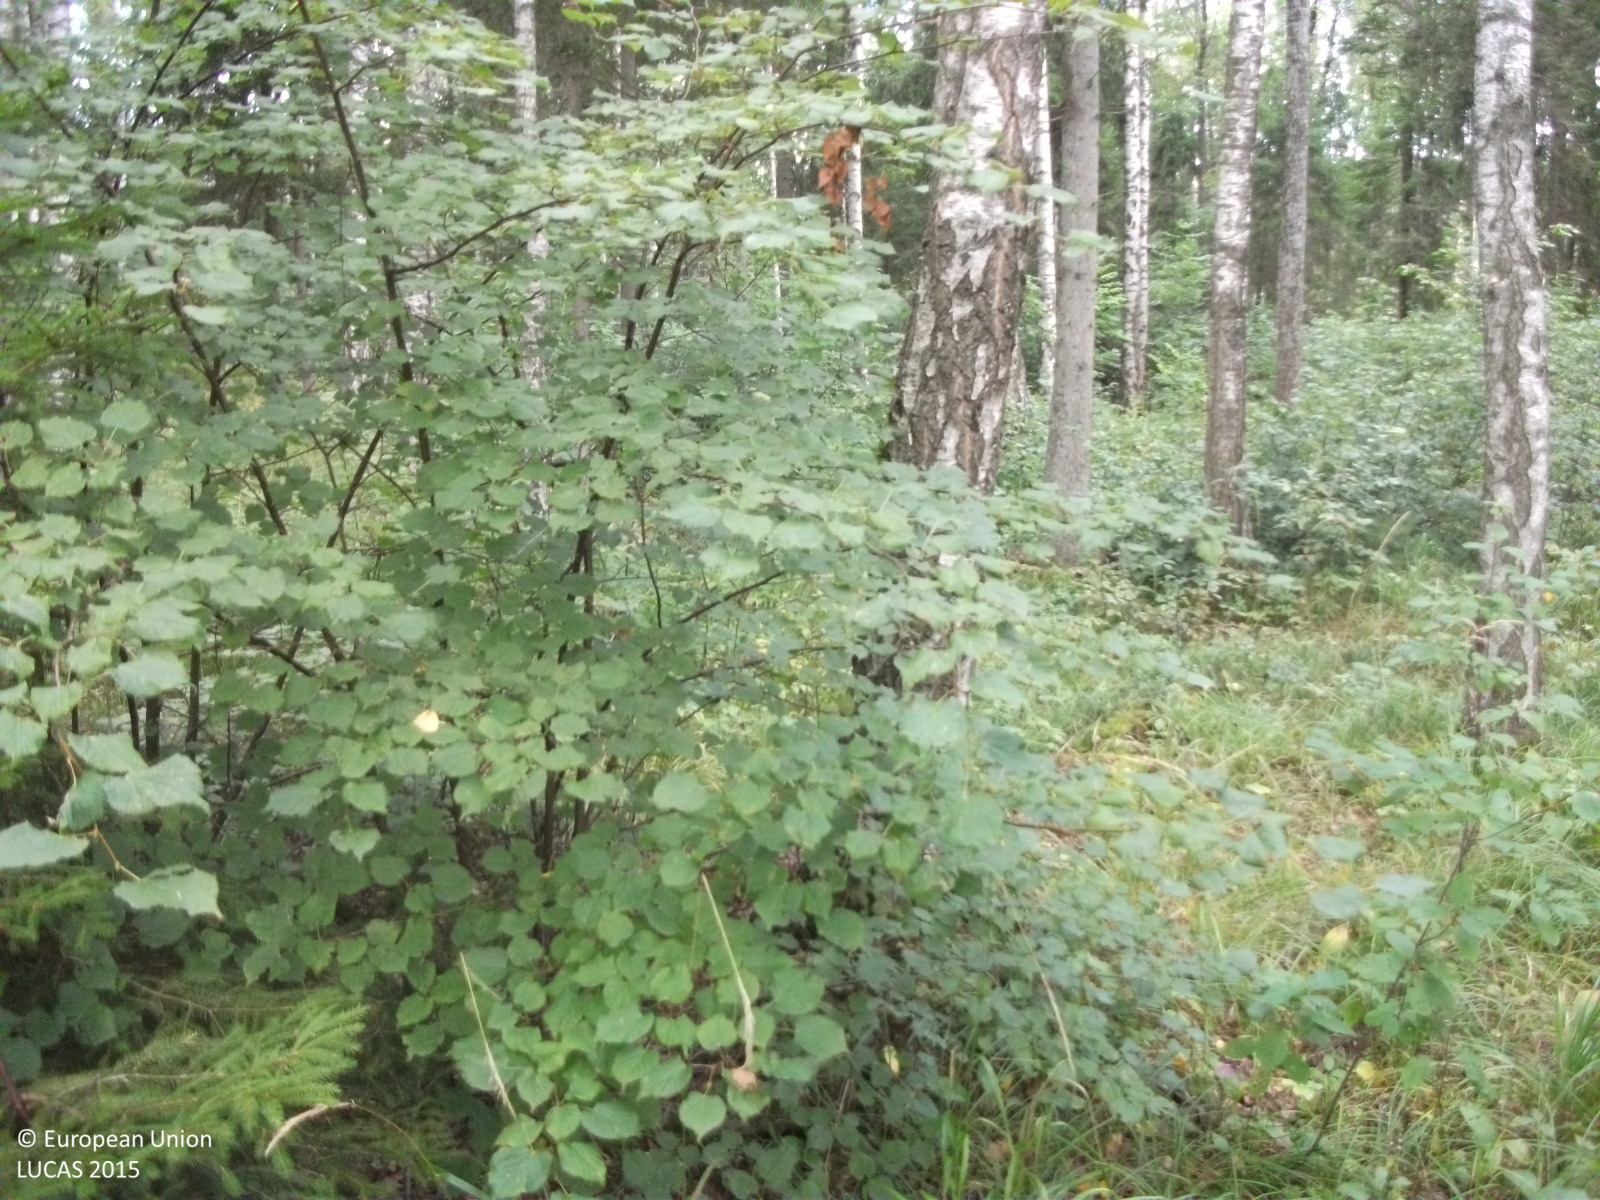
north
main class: Woodland
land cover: Spruce dominated mixed woodland
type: hemiboreal forest and nemoral coniferous forest and mixed broadleaved-coniferous forest
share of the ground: > 75 %
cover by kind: broadleaved forest trees 55 %, coniferous forest trees 30 %, herbaceous plants 10 %, shrubs 5 %
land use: Forestry
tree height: > 5 m
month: September
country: LV
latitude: 57.5611
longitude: 24.4479
